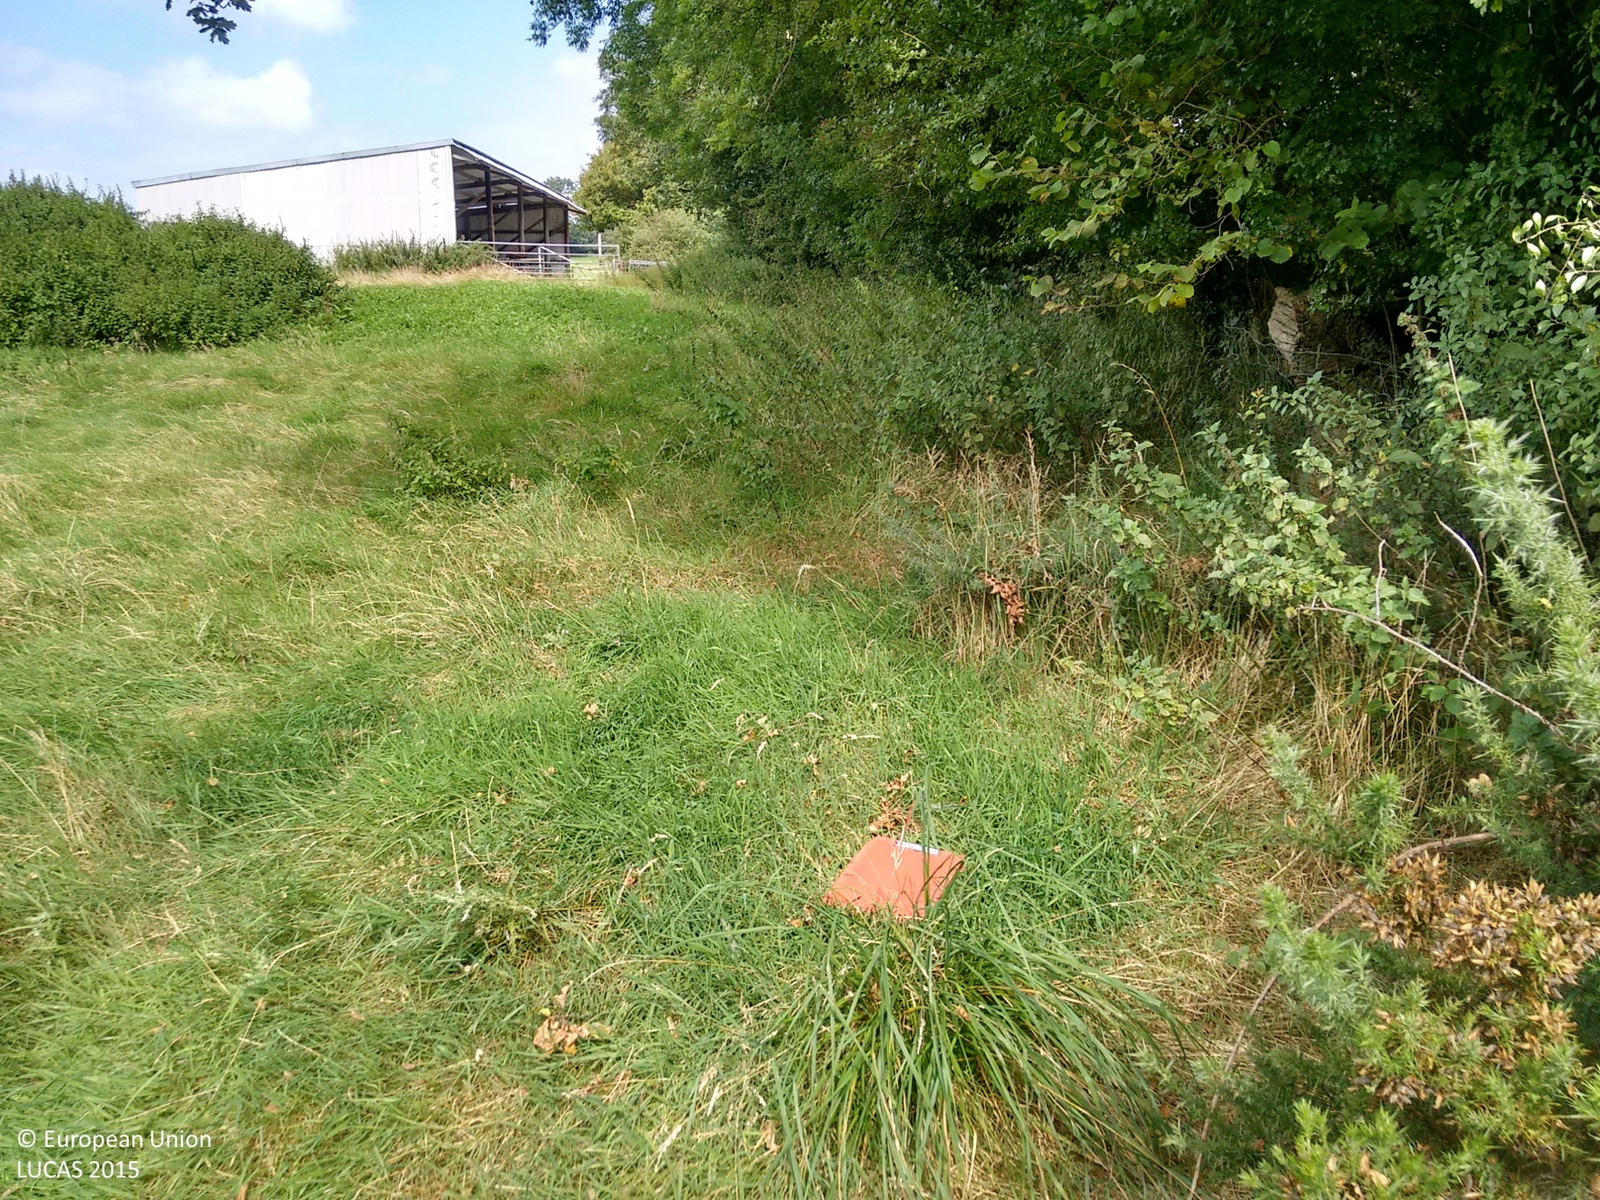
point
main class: Grassland
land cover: Grassland without tree/shrub cover
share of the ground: > 75 %
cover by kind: herbaceous plants 100 %
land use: Agriculture (excluding fallow land and kitchen gardens)
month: September
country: GB
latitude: 50.9406
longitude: -4.2891
